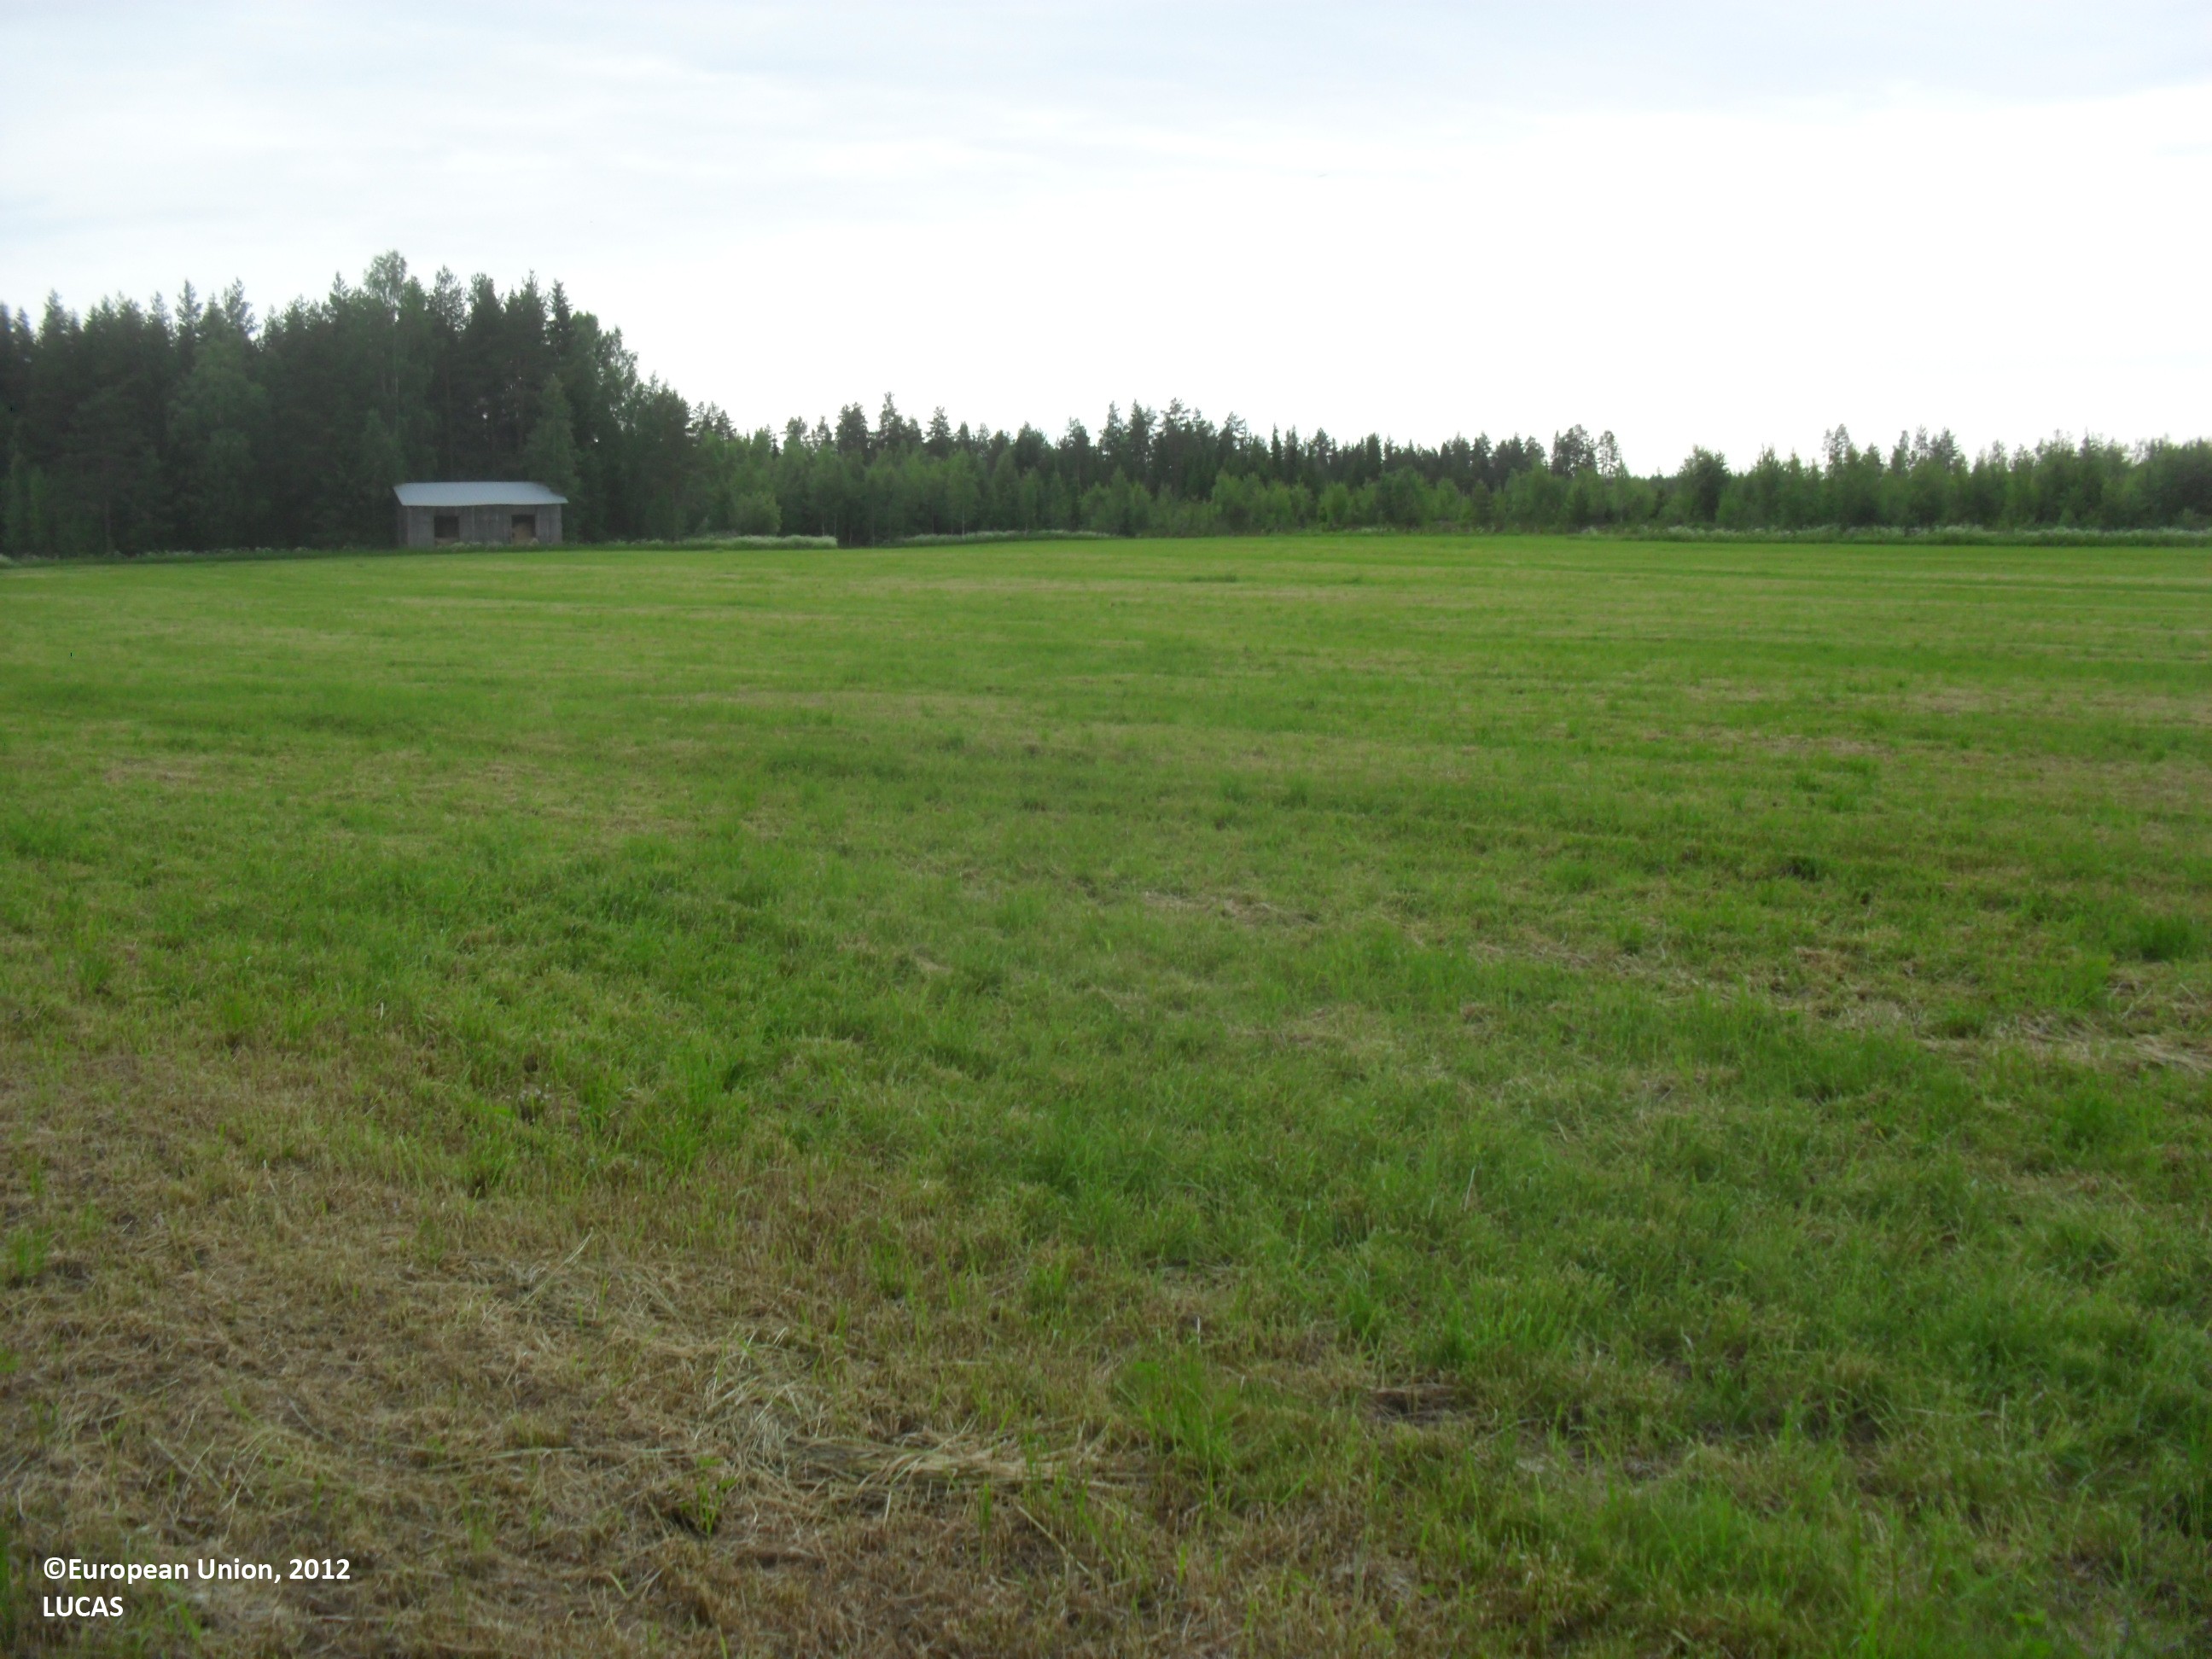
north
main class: Grassland
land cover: Grassland without tree/shrub cover
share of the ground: > 75 %
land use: Agriculture (excluding fallow land and kitchen gardens)
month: June
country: FI
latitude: 63.4831
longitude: 23.1257
